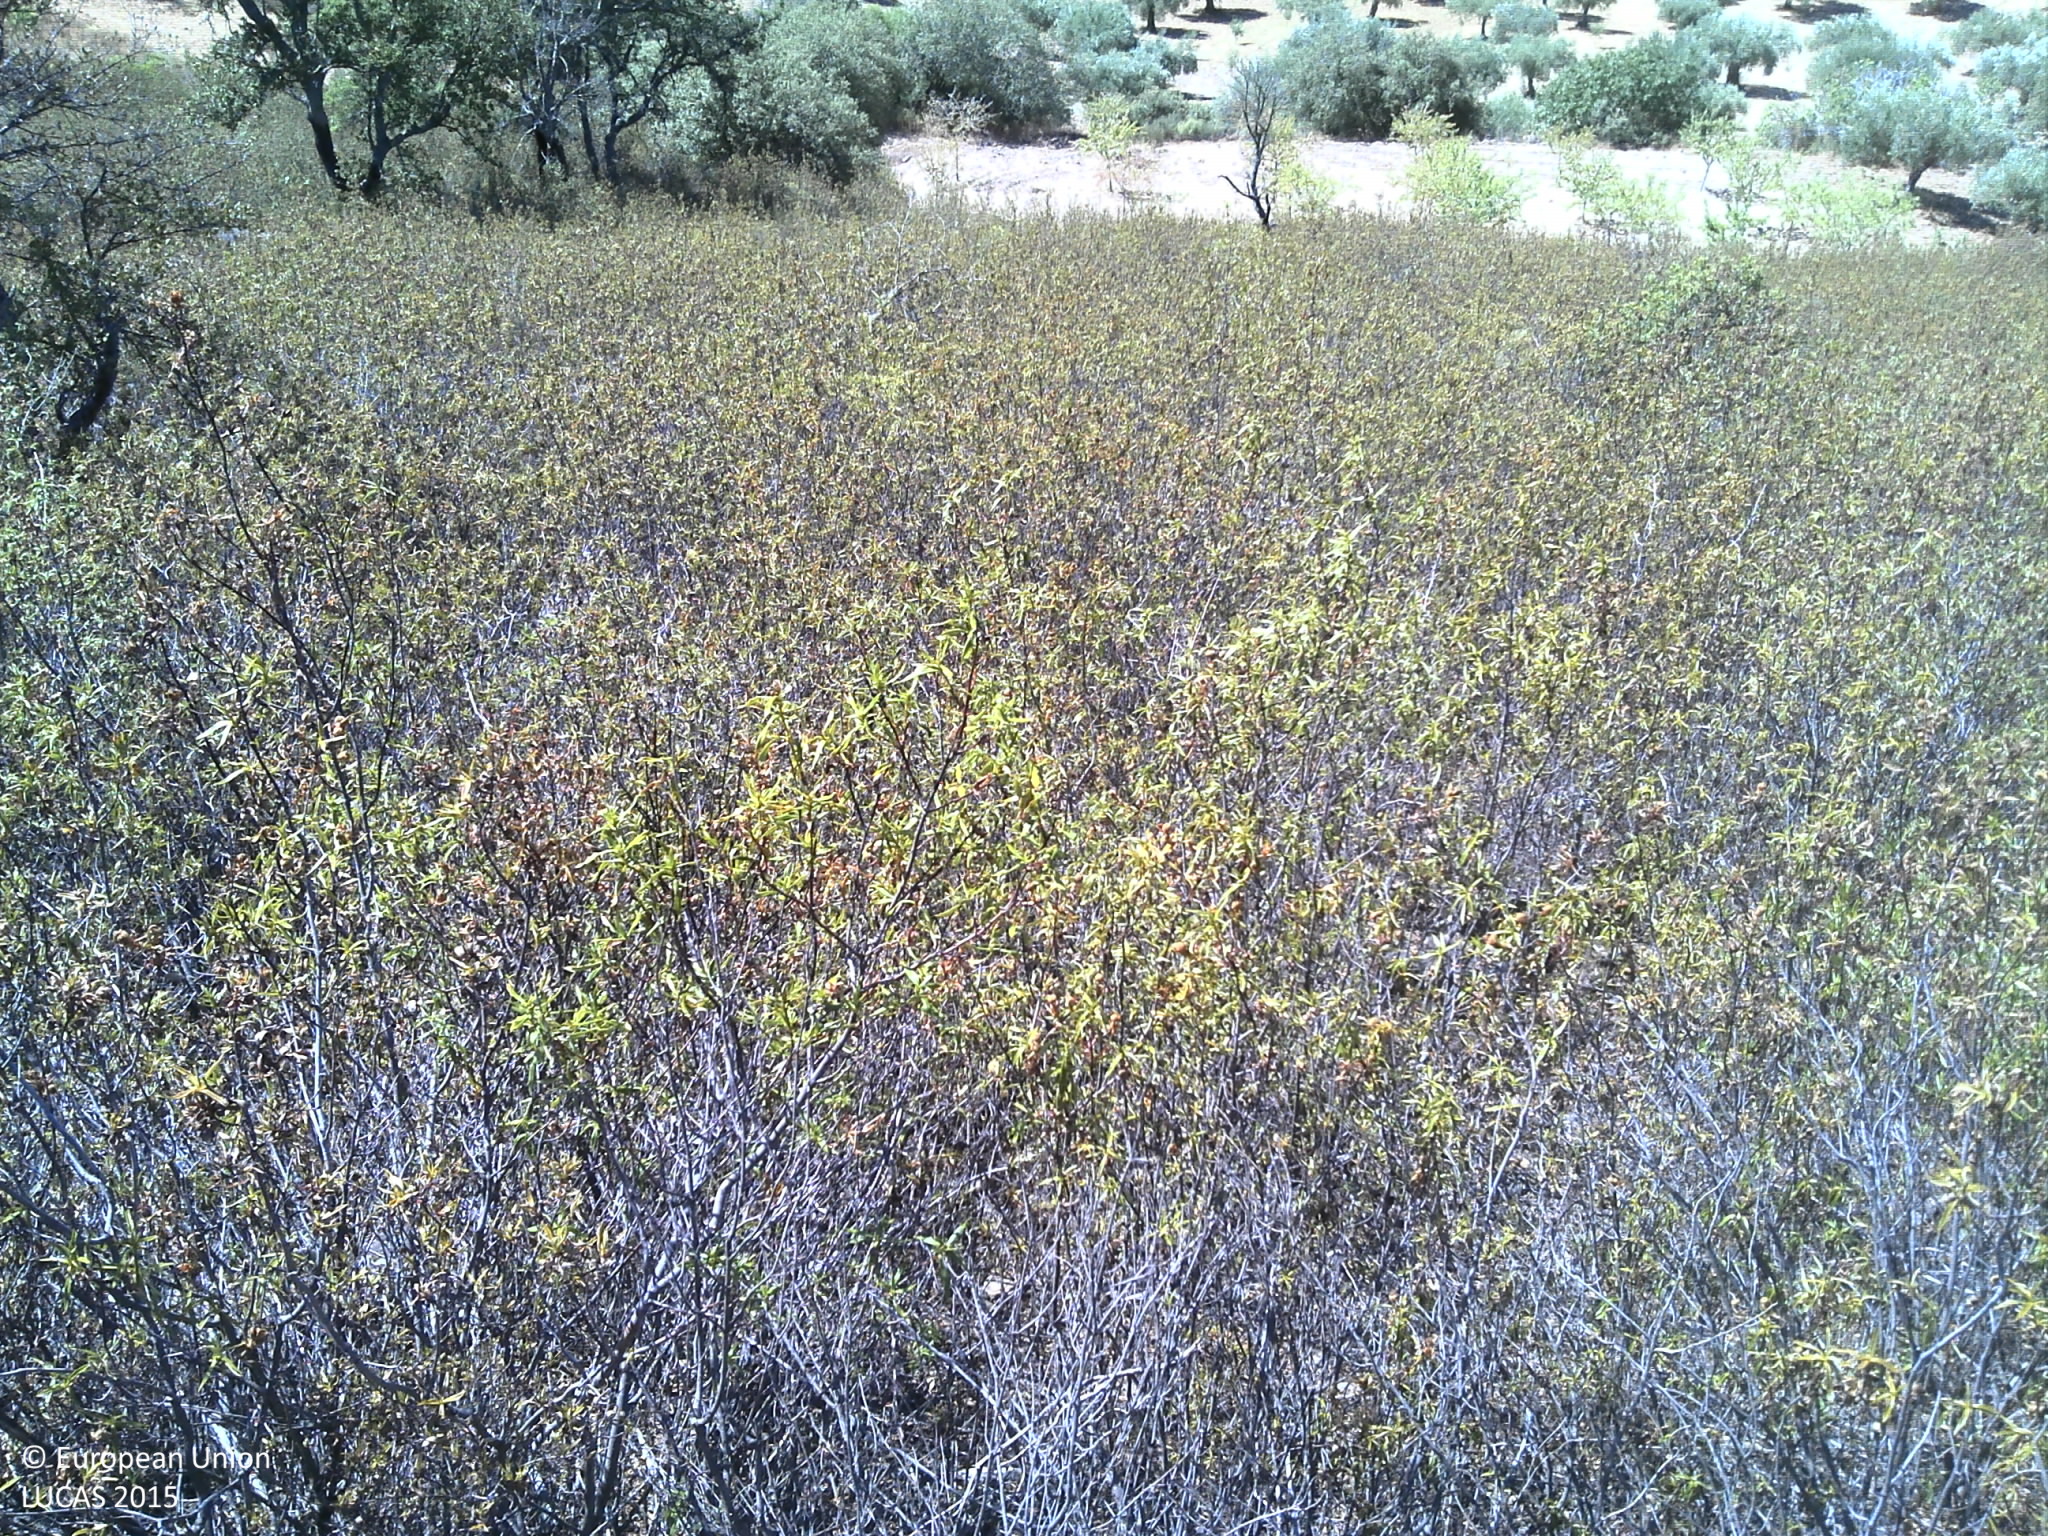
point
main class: Shrubland
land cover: Shrubland with sparse tree cover
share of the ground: > 75 %
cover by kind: shrubs 95 %, broadleaved forest trees 5 %
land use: Semi-natural and natural areas not in use
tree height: > 5 m
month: July
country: PT
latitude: 41.4016
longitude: -7.1375
